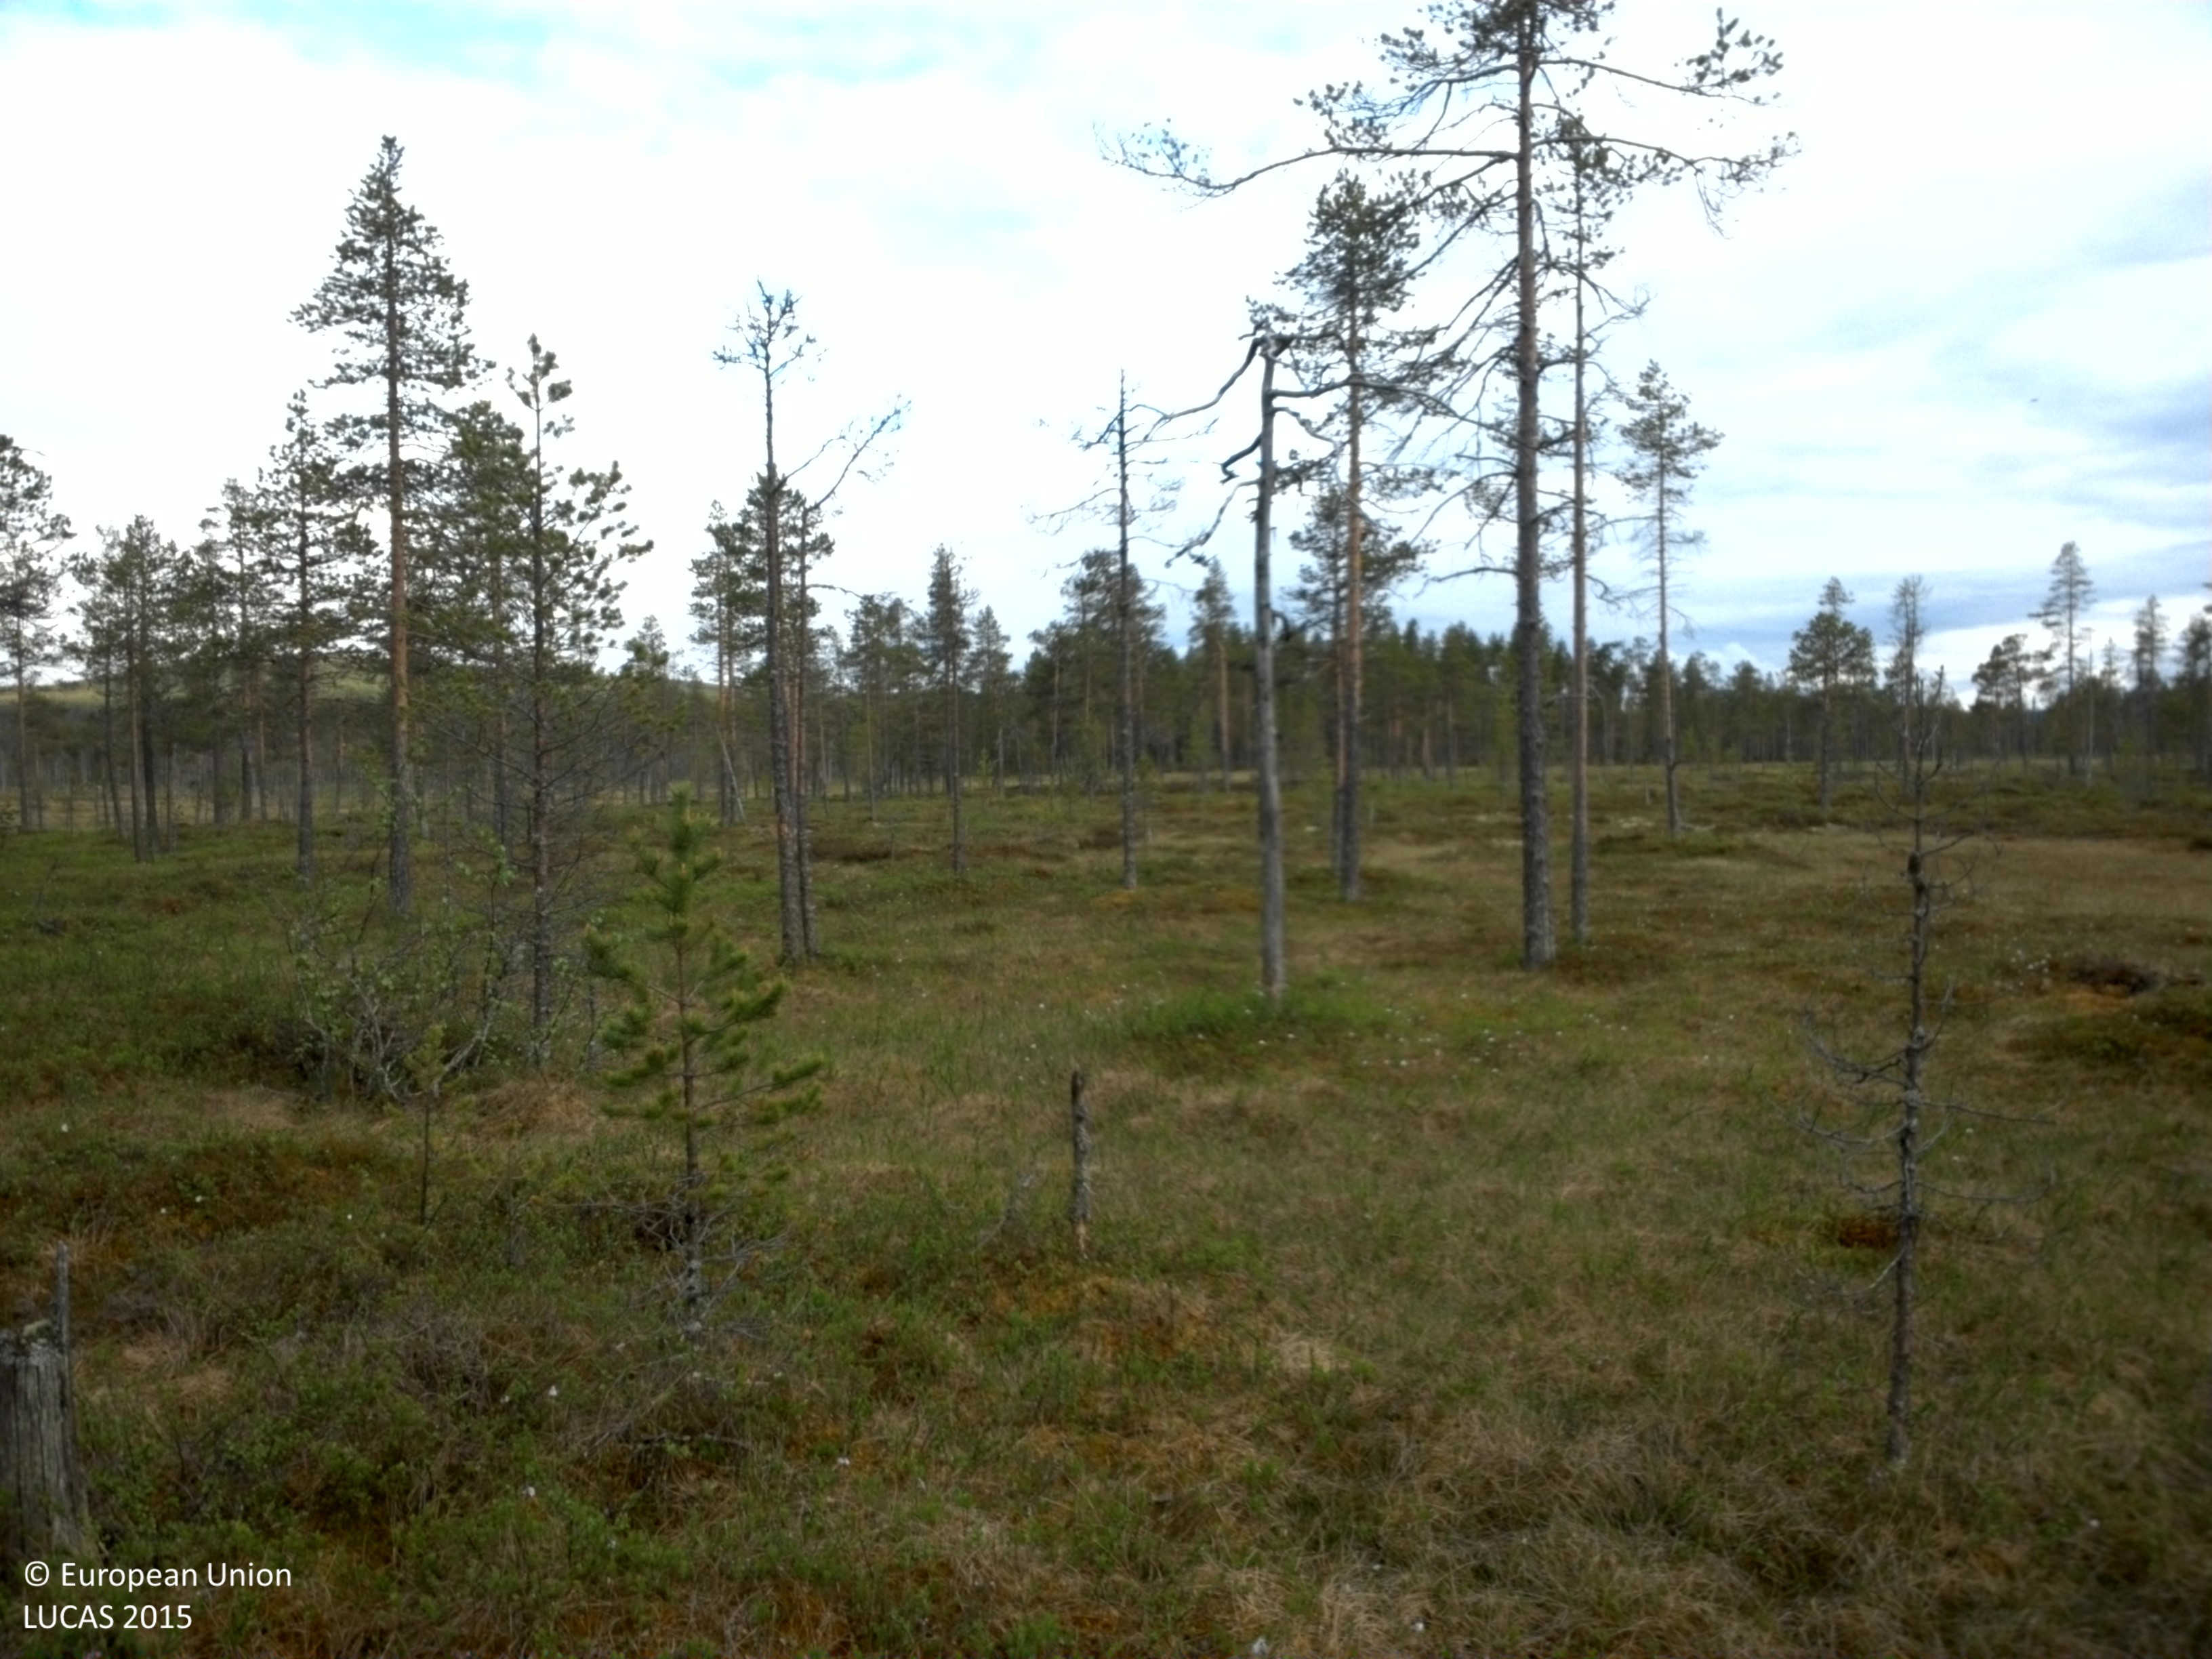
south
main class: Woodland
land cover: Pine dominated coniferous woodland
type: boreal forest
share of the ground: 10 - 25 %
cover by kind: shrubs 50 %, lichens and mosses 30 %, coniferous forest trees 15 %, herbaceous plants 5 %
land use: Forestry
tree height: > 5 m
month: June
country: SE
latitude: 62.0971
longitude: 13.7202
